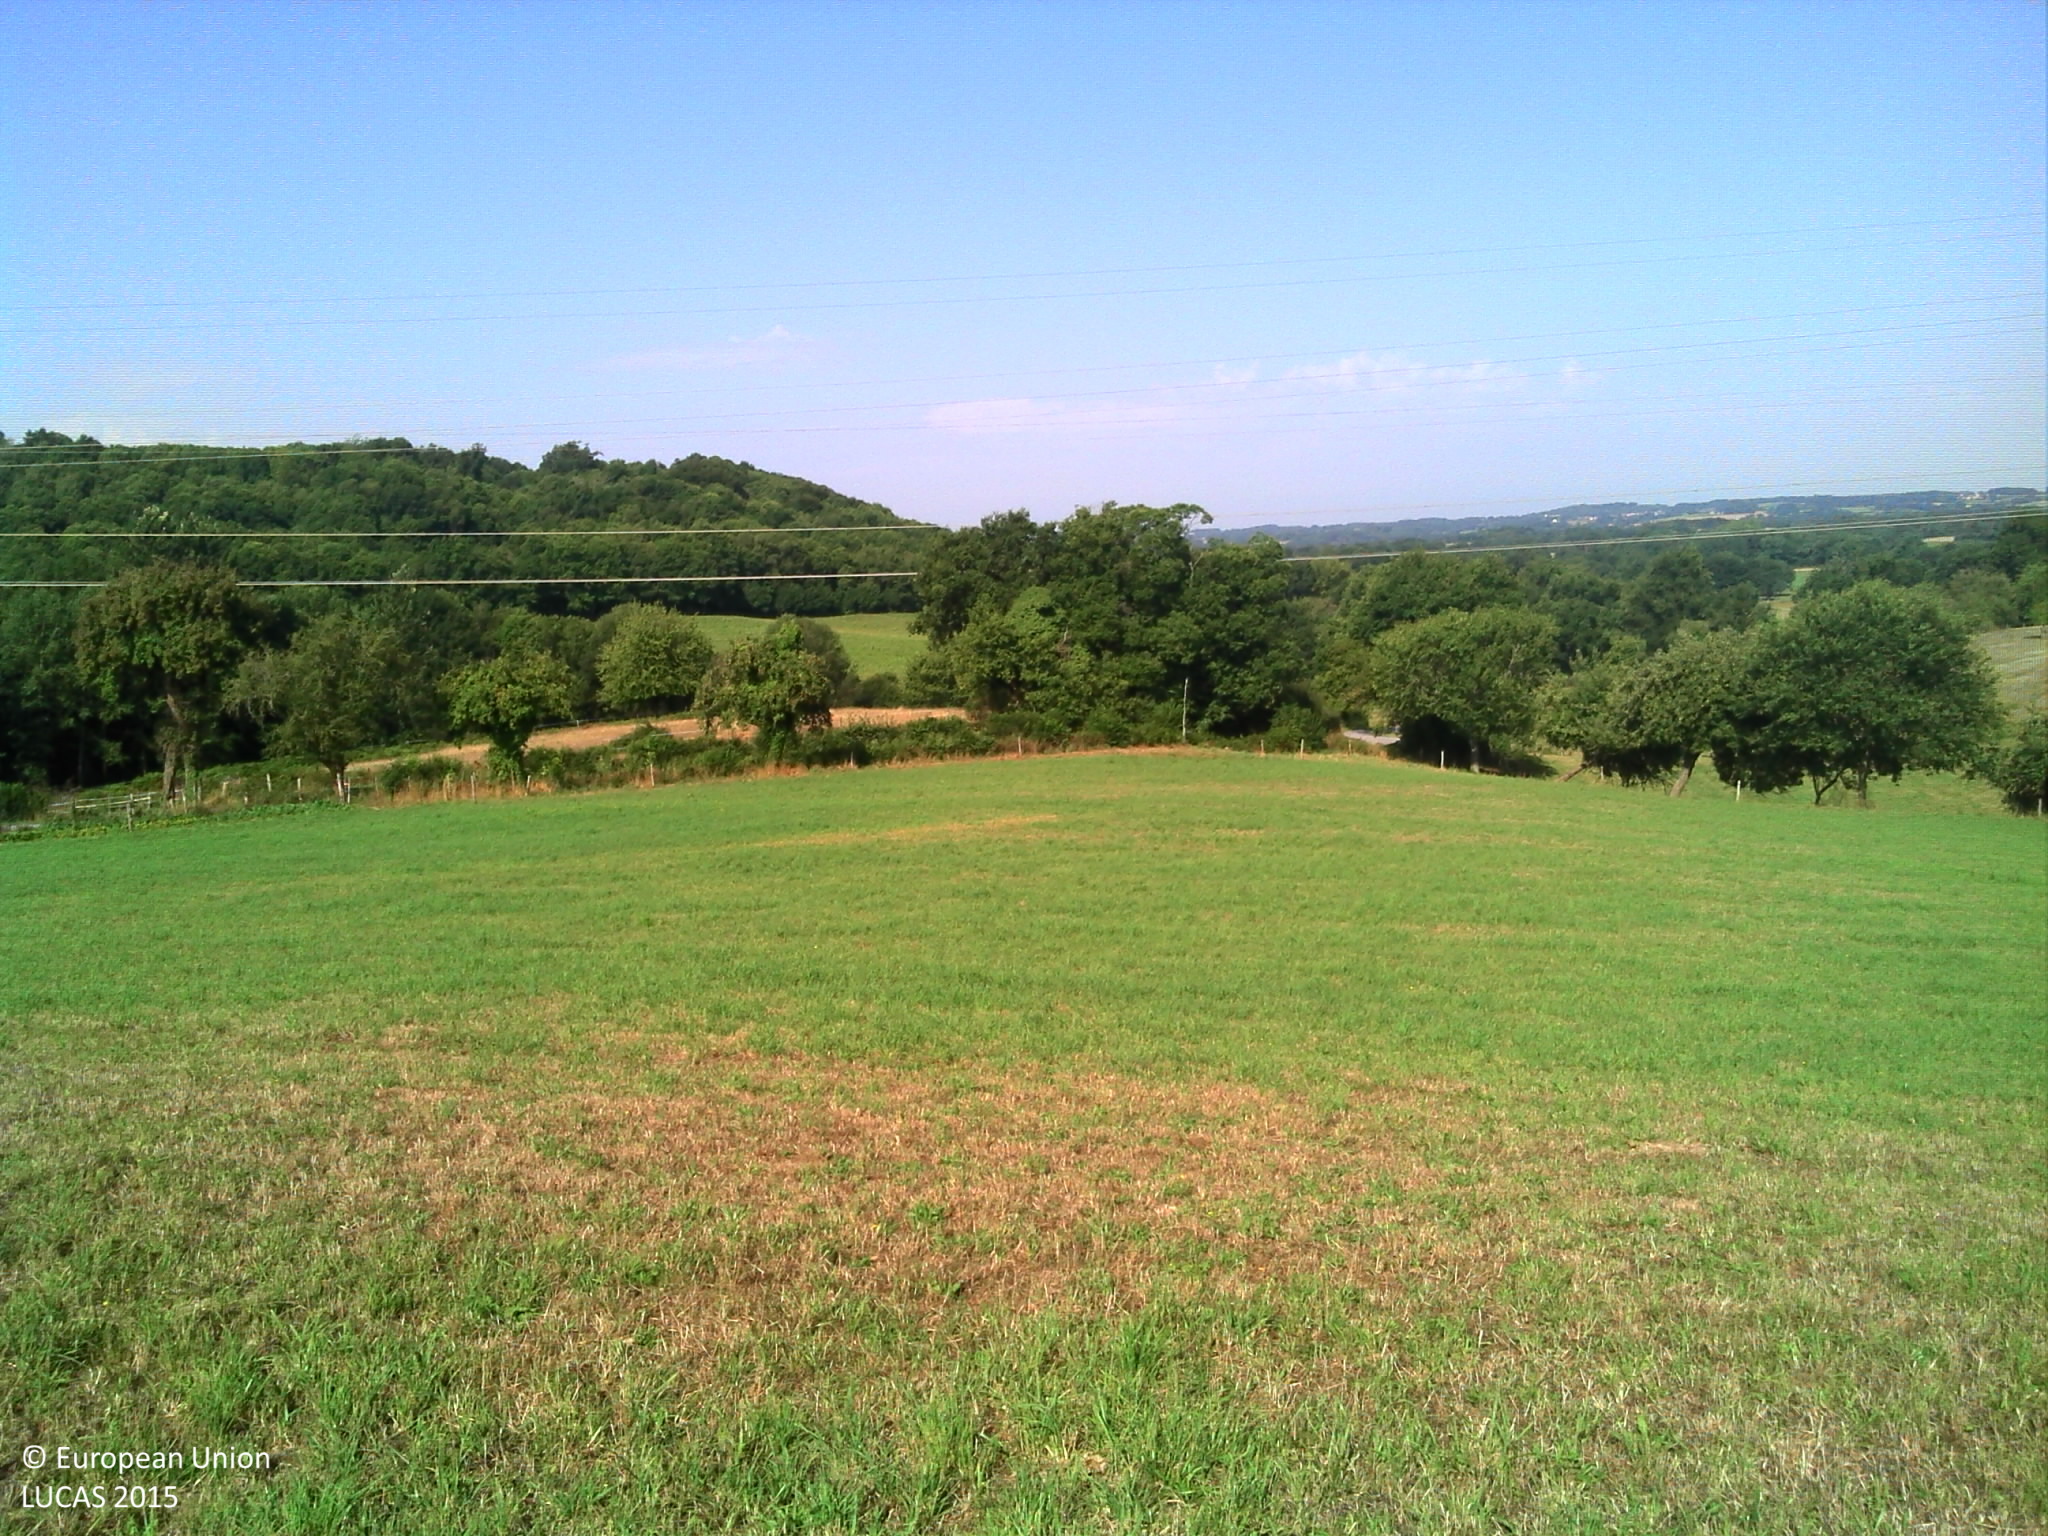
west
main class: Cropland
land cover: Temporary grasslands
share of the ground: > 75 %
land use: Agriculture (excluding fallow land and kitchen gardens)
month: August
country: FR
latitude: 46.1881
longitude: 1.6609
